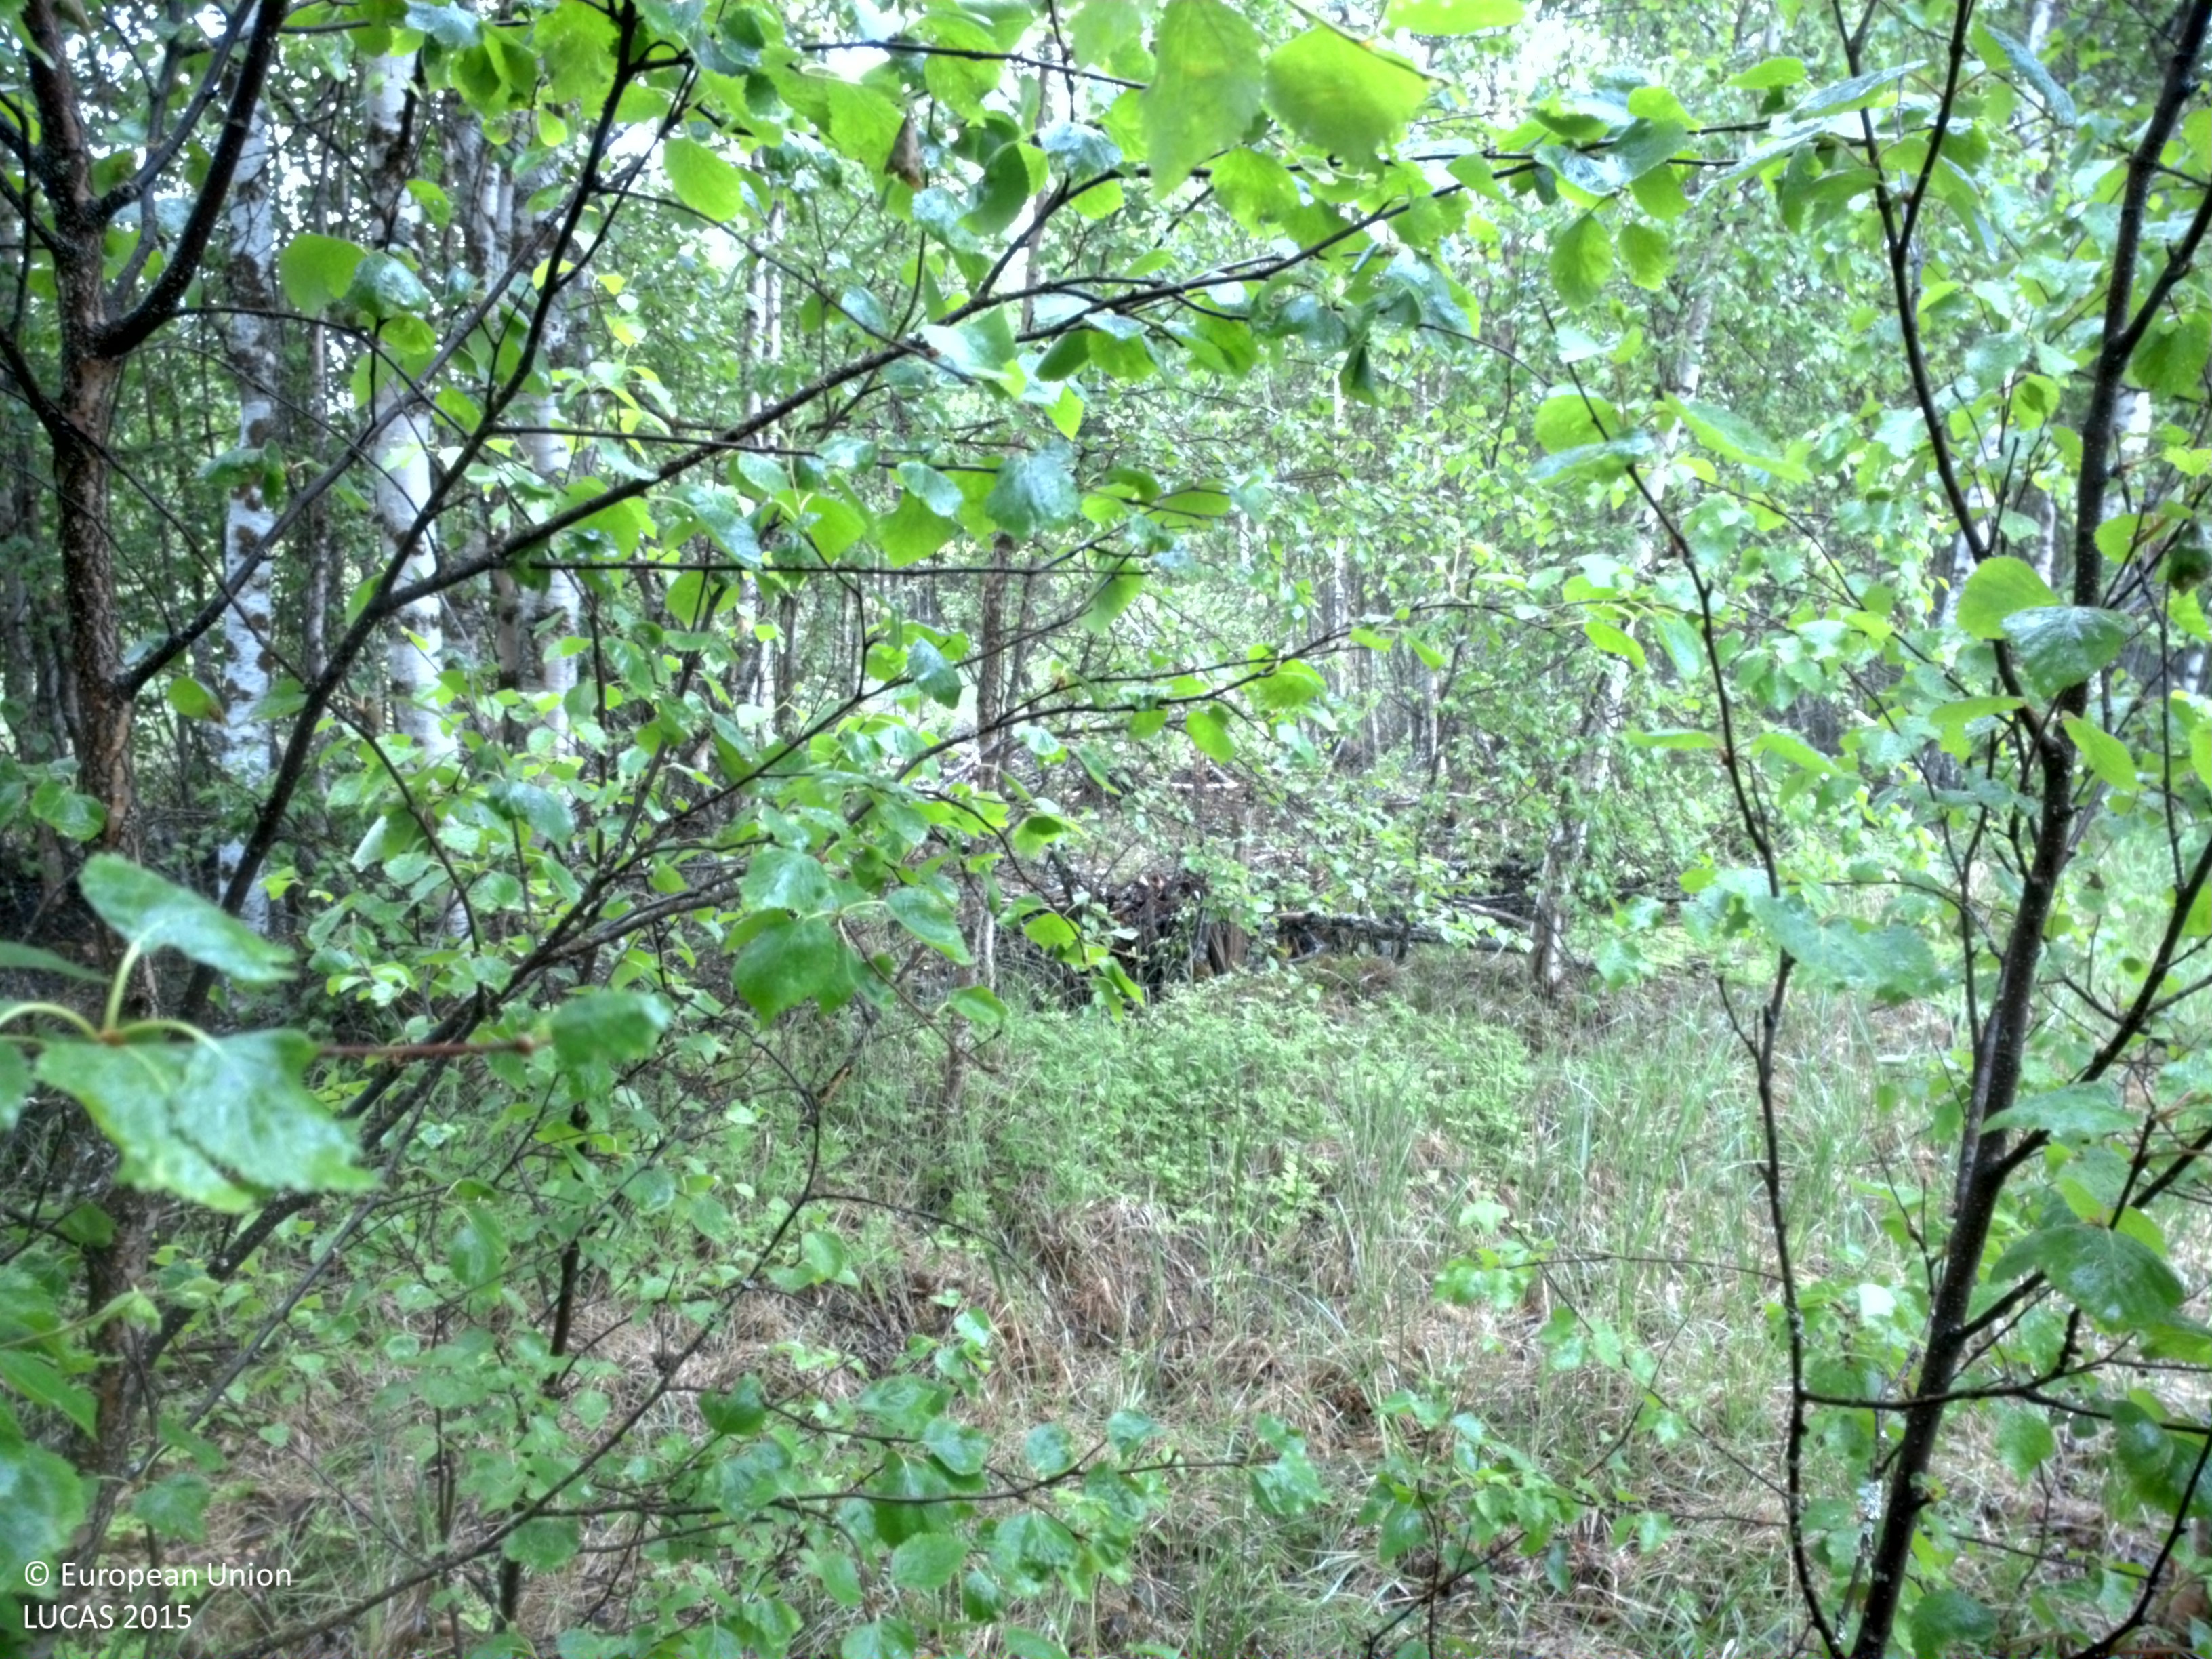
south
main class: Woodland
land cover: Broadleaved woodland
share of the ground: > 75 %
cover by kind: broadleaved forest trees 85 %, shrubs 5 %, herbaceous plants 5 %, lichens and mosses 5 %
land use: Forestry
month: June
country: SE
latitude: 66.3761
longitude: 22.7906
